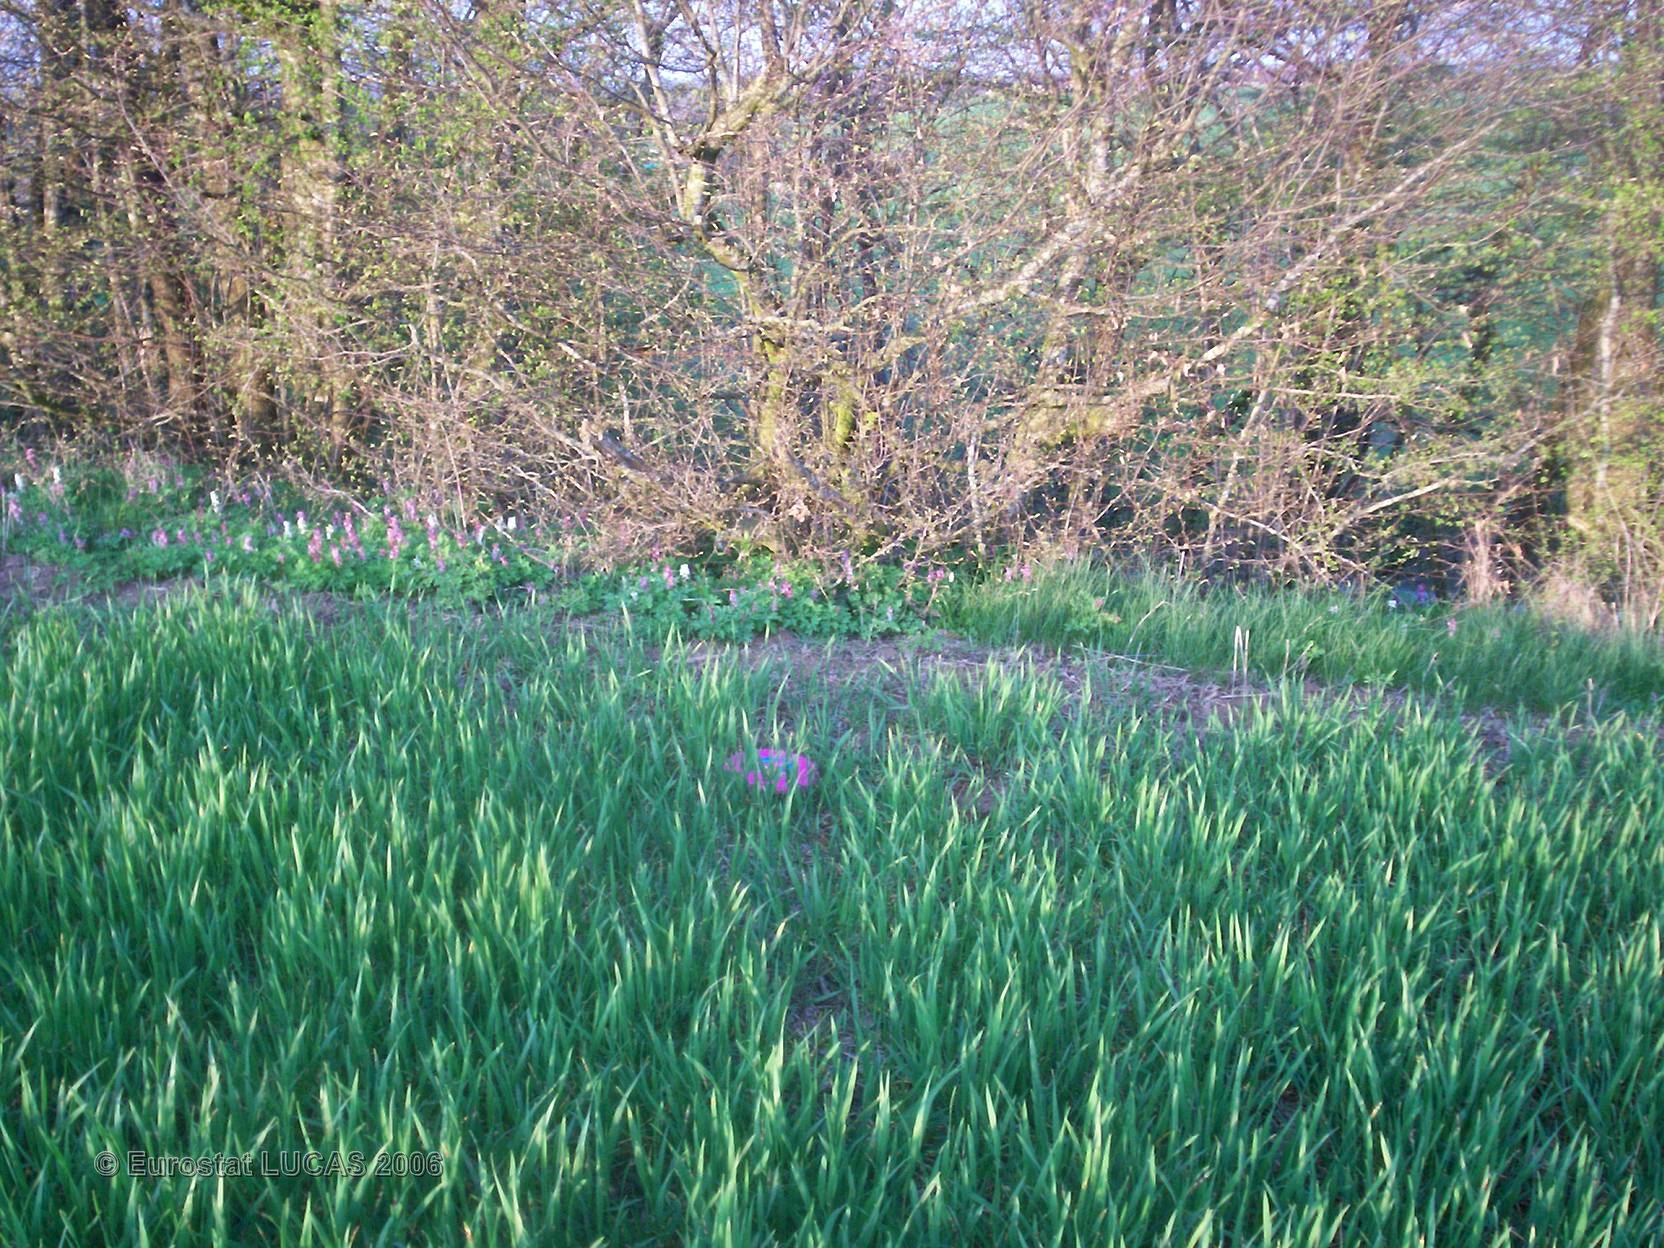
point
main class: Cropland
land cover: Barley
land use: Agriculture (excluding fallow land and kitchen gardens)
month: April
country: FR
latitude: 47.4768
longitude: 6.2994
